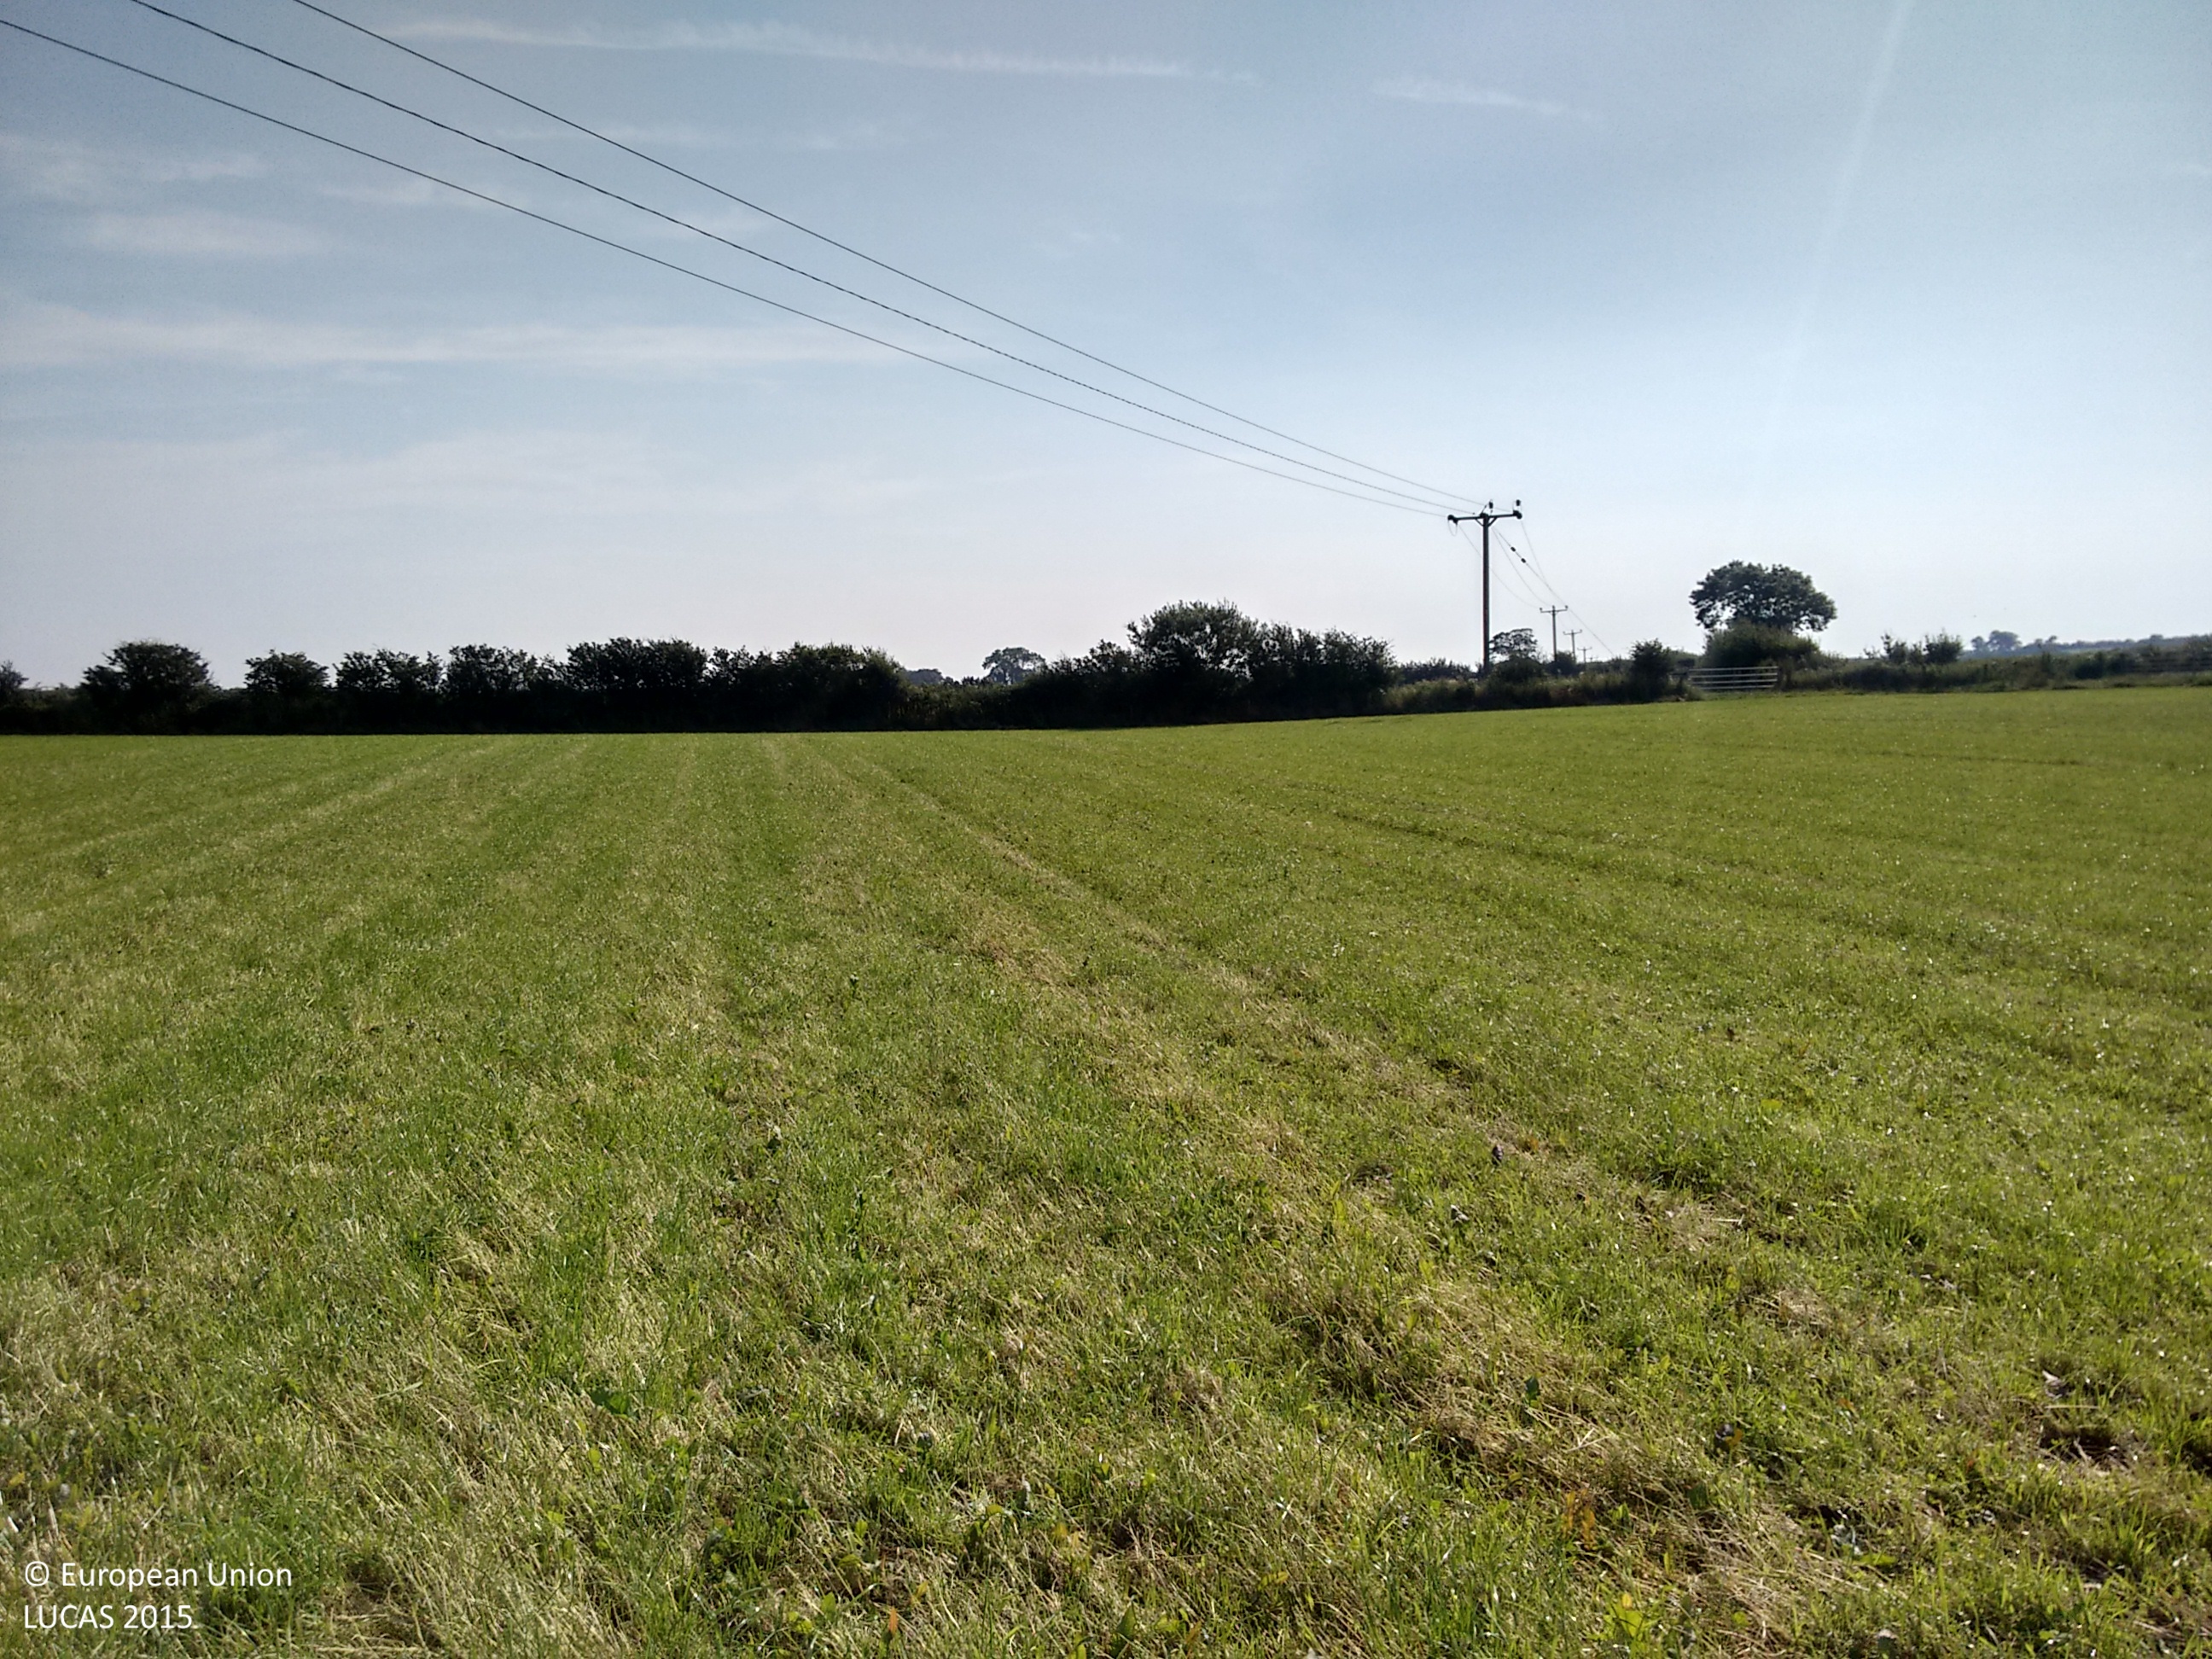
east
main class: Cropland
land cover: Temporary grasslands
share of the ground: > 75 %
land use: Agriculture (excluding fallow land and kitchen gardens)
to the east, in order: Temporary grasslands; Electric lines; Temporary grasslands; Managed hedges; Fences; Grassland without tree/shrub cover; Fences; Managed hedges; Grassland without tree/shrub cover
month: August
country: GB
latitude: 54.8382
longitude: -3.2646
